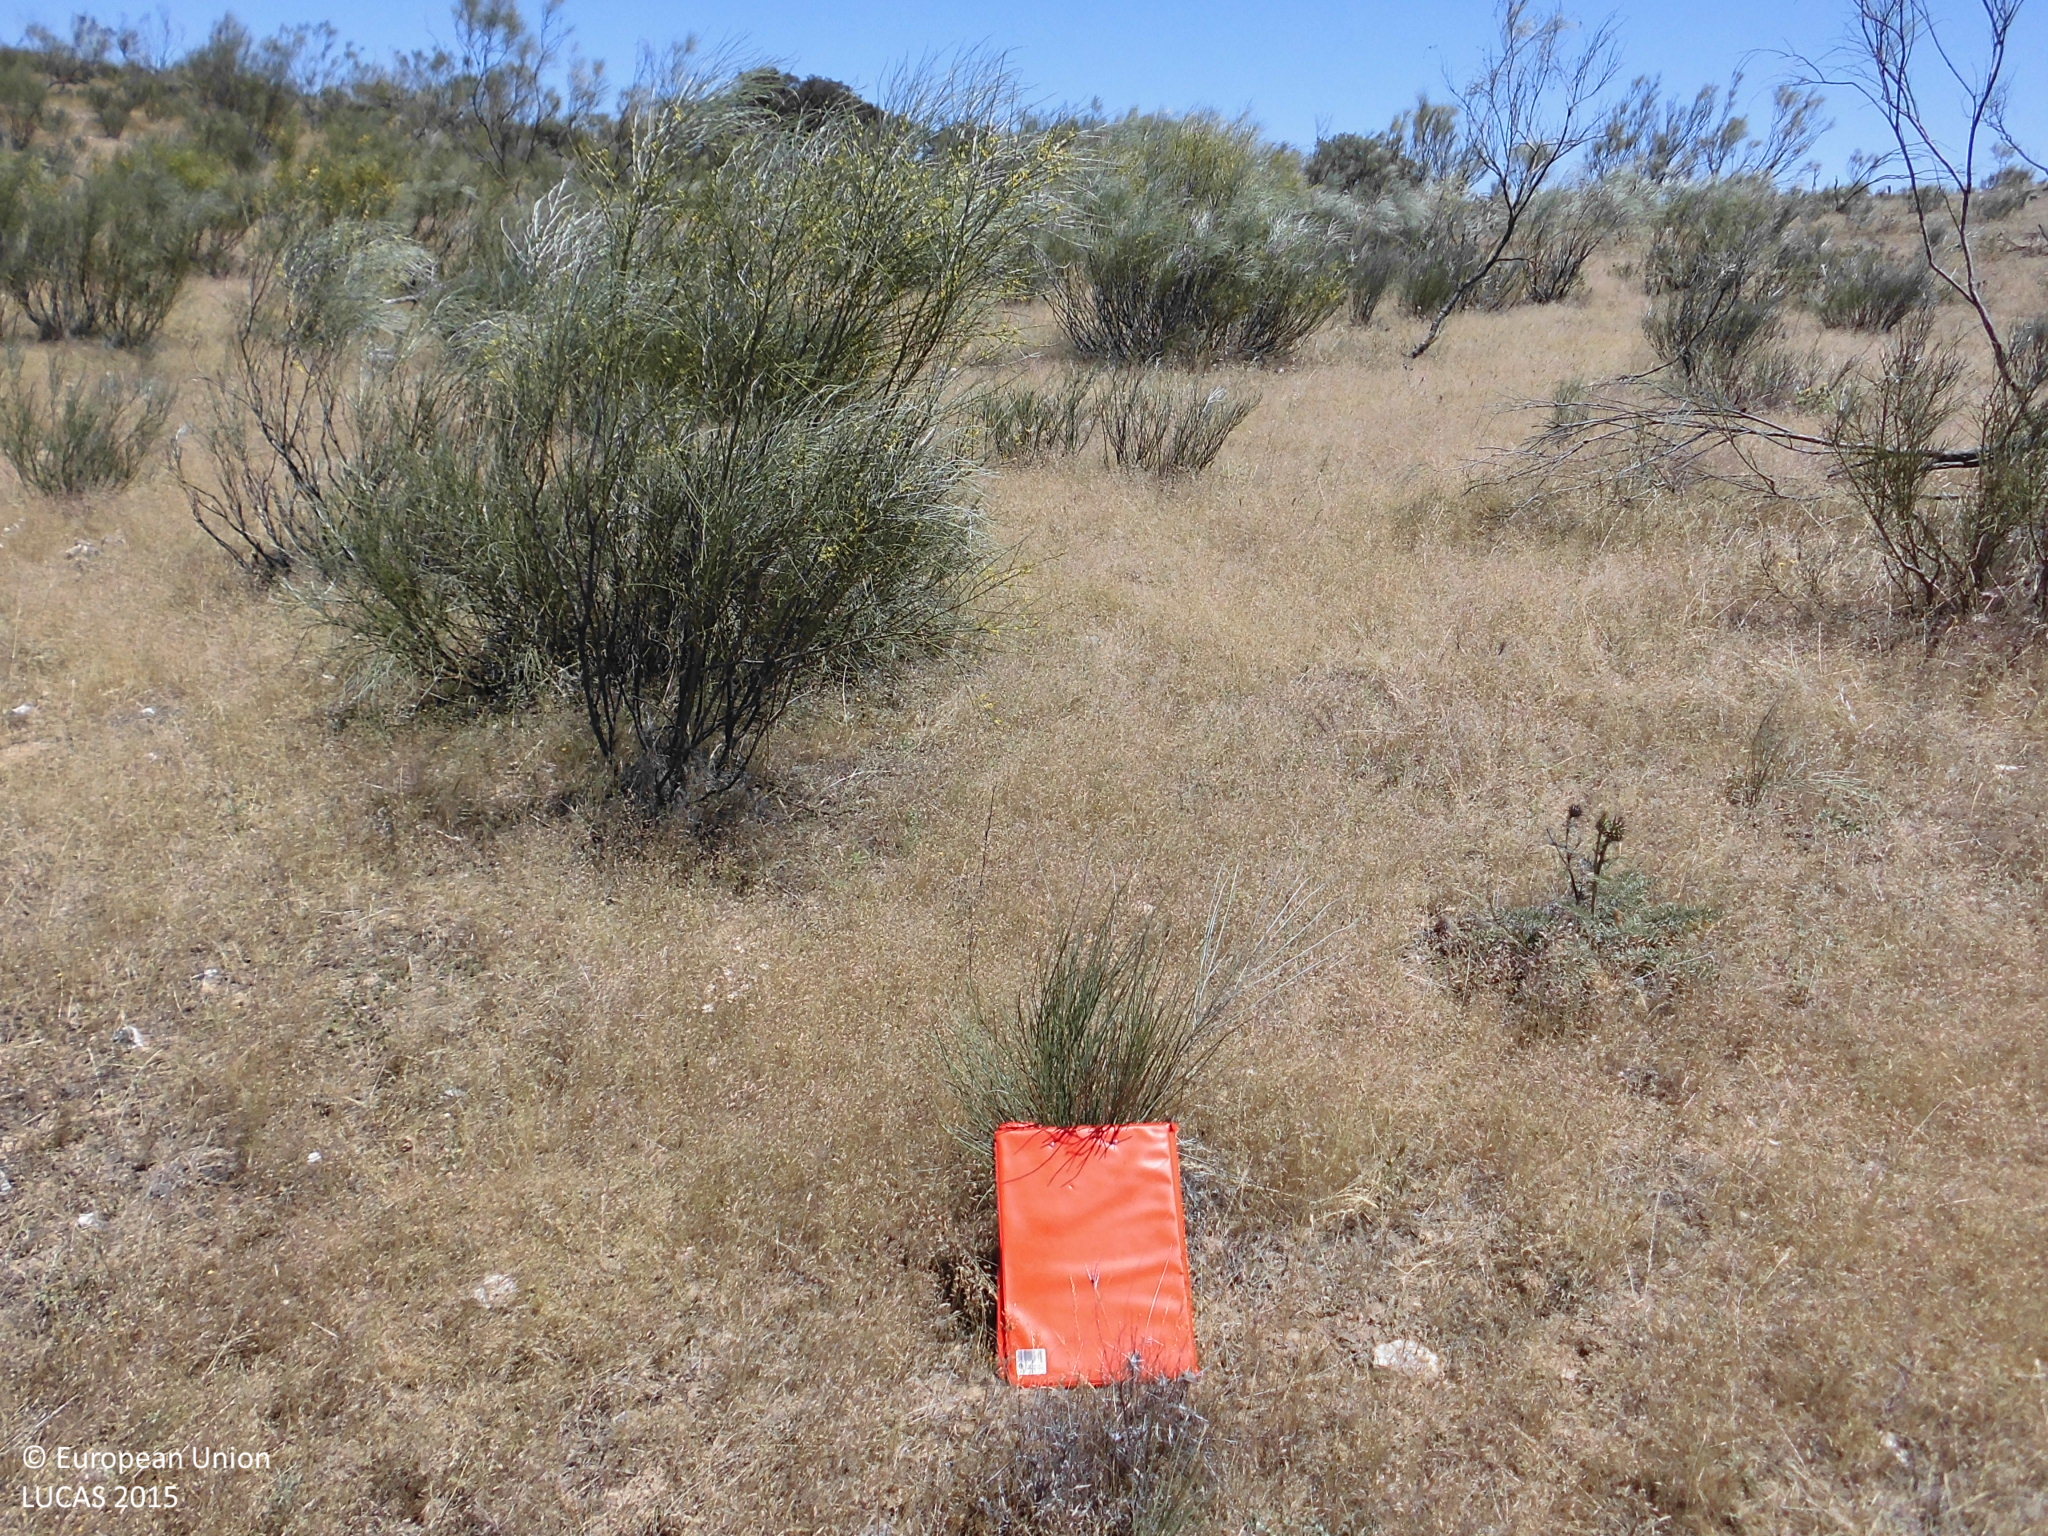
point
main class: Shrubland
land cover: Shrubland without tree cover
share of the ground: 10 - 25 %
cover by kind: herbaceous plants 85 %, shrubs 15 %
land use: Agriculture (excluding fallow land and kitchen gardens)
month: May
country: ES
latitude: 39.4852
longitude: -6.9266
